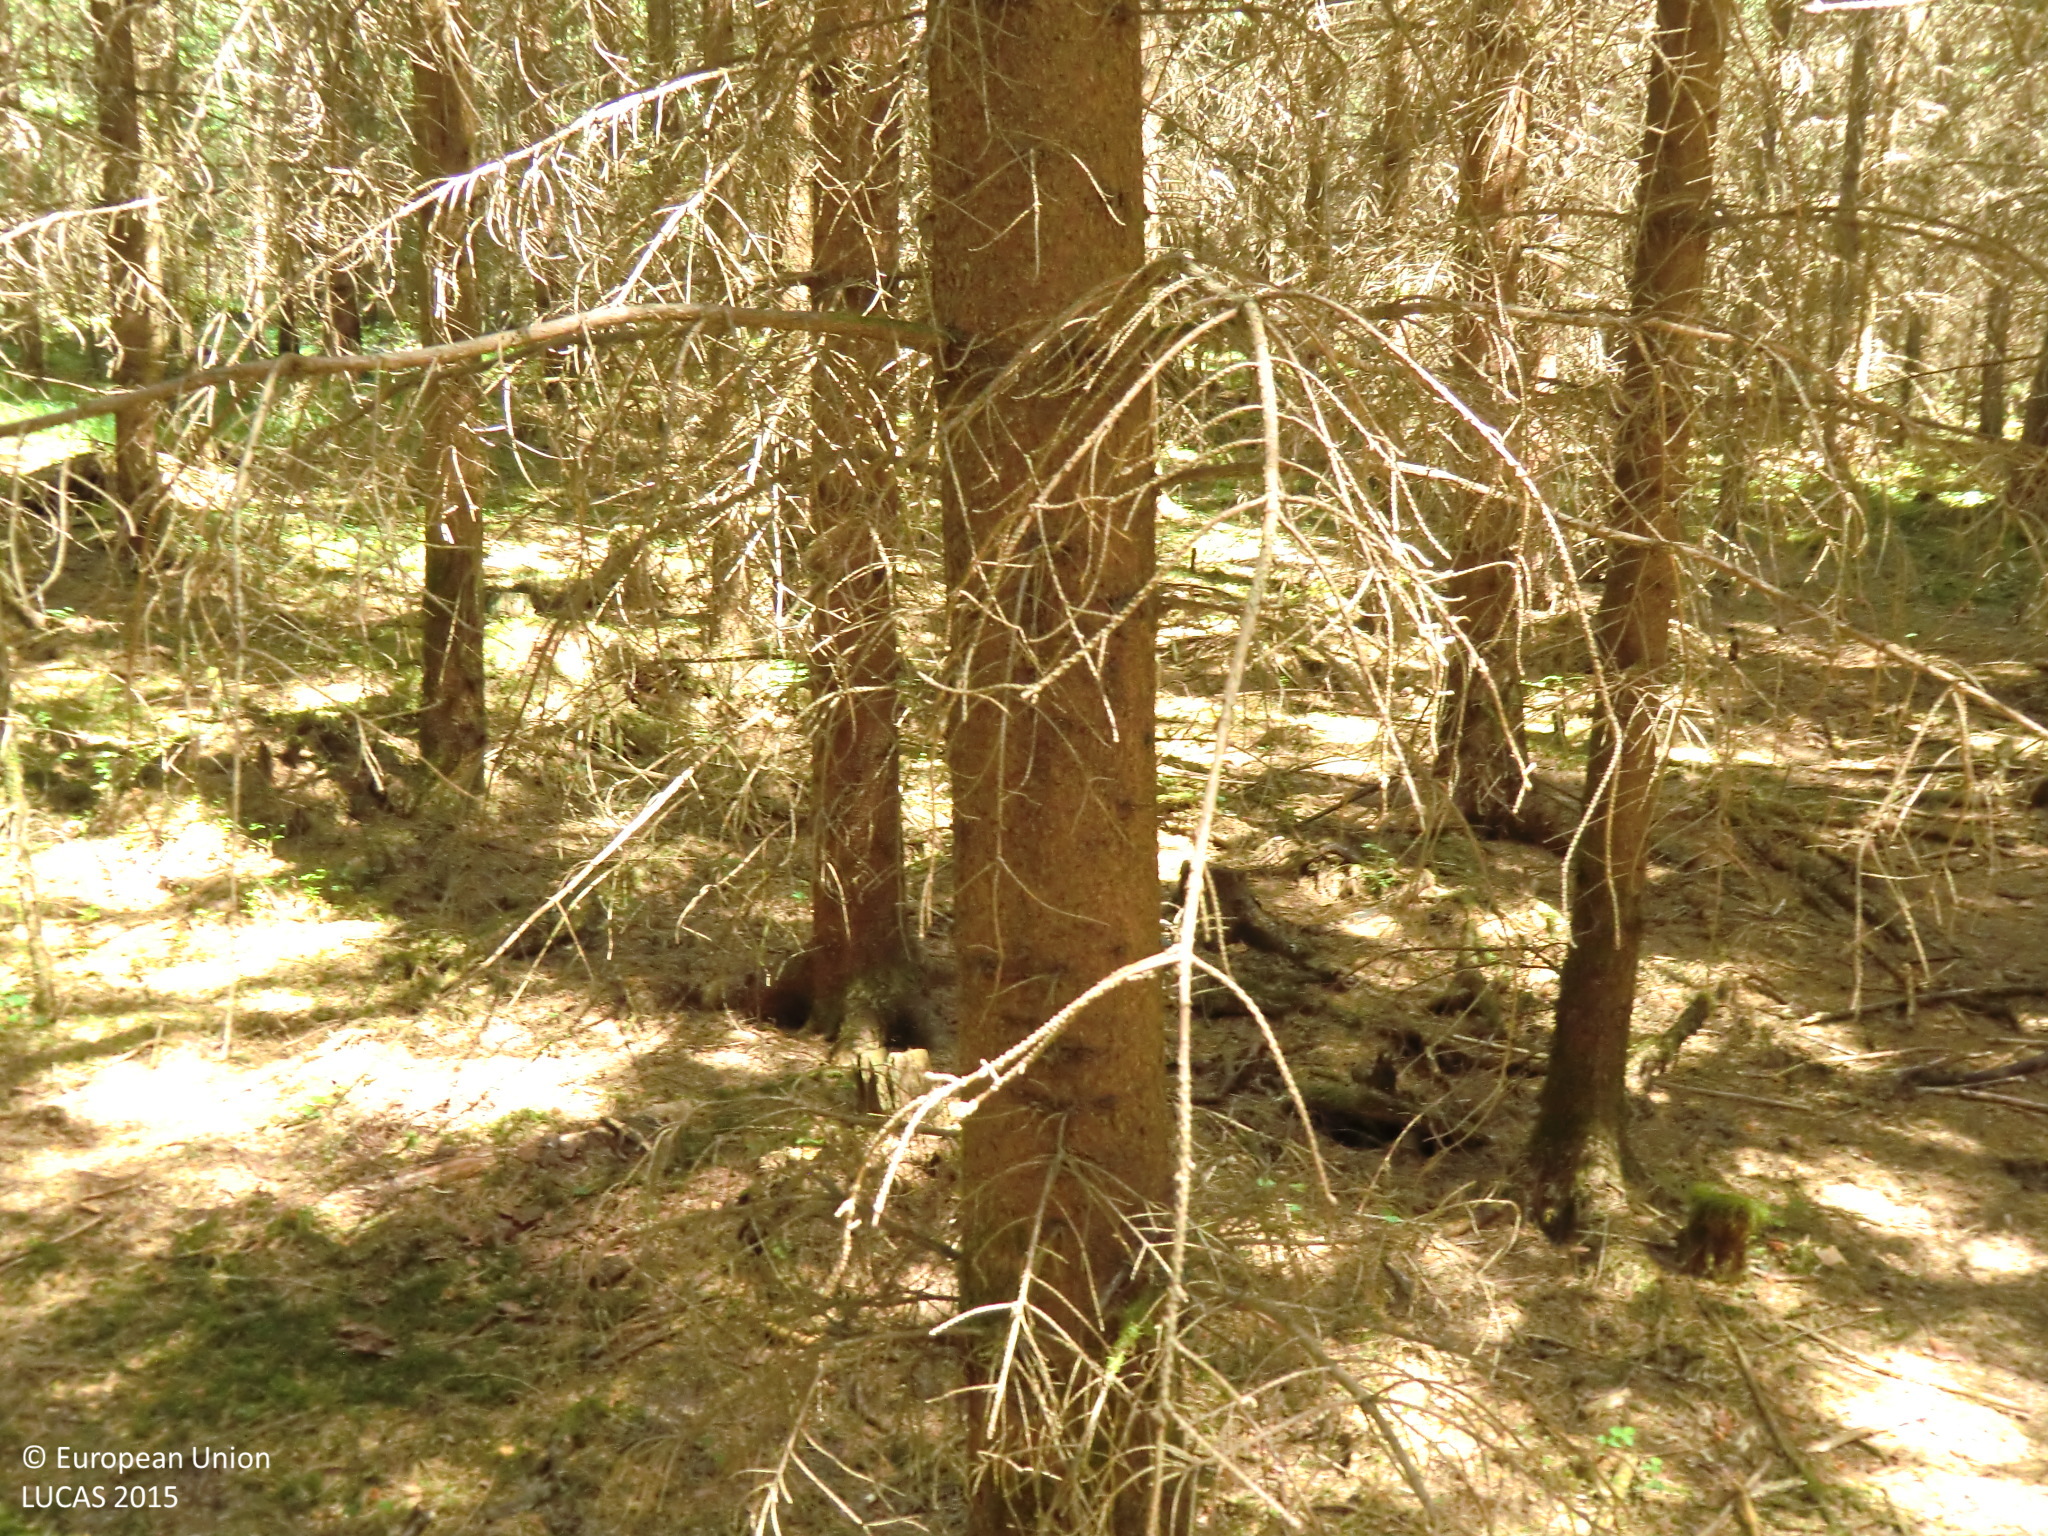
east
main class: Woodland
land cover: Spruce dominated coniferous woodland
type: hemiboreal forest and nemoral coniferous forest and mixed broadleaved-coniferous forest
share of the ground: > 75 %
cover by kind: coniferous forest trees 90 %, unconsolidated bare surface 10 %
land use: Forestry
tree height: > 5 m
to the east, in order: Spruce dominated coniferous woodland; Tracks; Spruce dominated coniferous woodland; Tracks; Spruce dominated coniferous woodland; Tracks; Spruce dominated coniferous woodland; Grassland without tree/shrub cover; Spruce dominated coniferous woodland
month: June
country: AT
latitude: 48.5659
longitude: 14.4591
